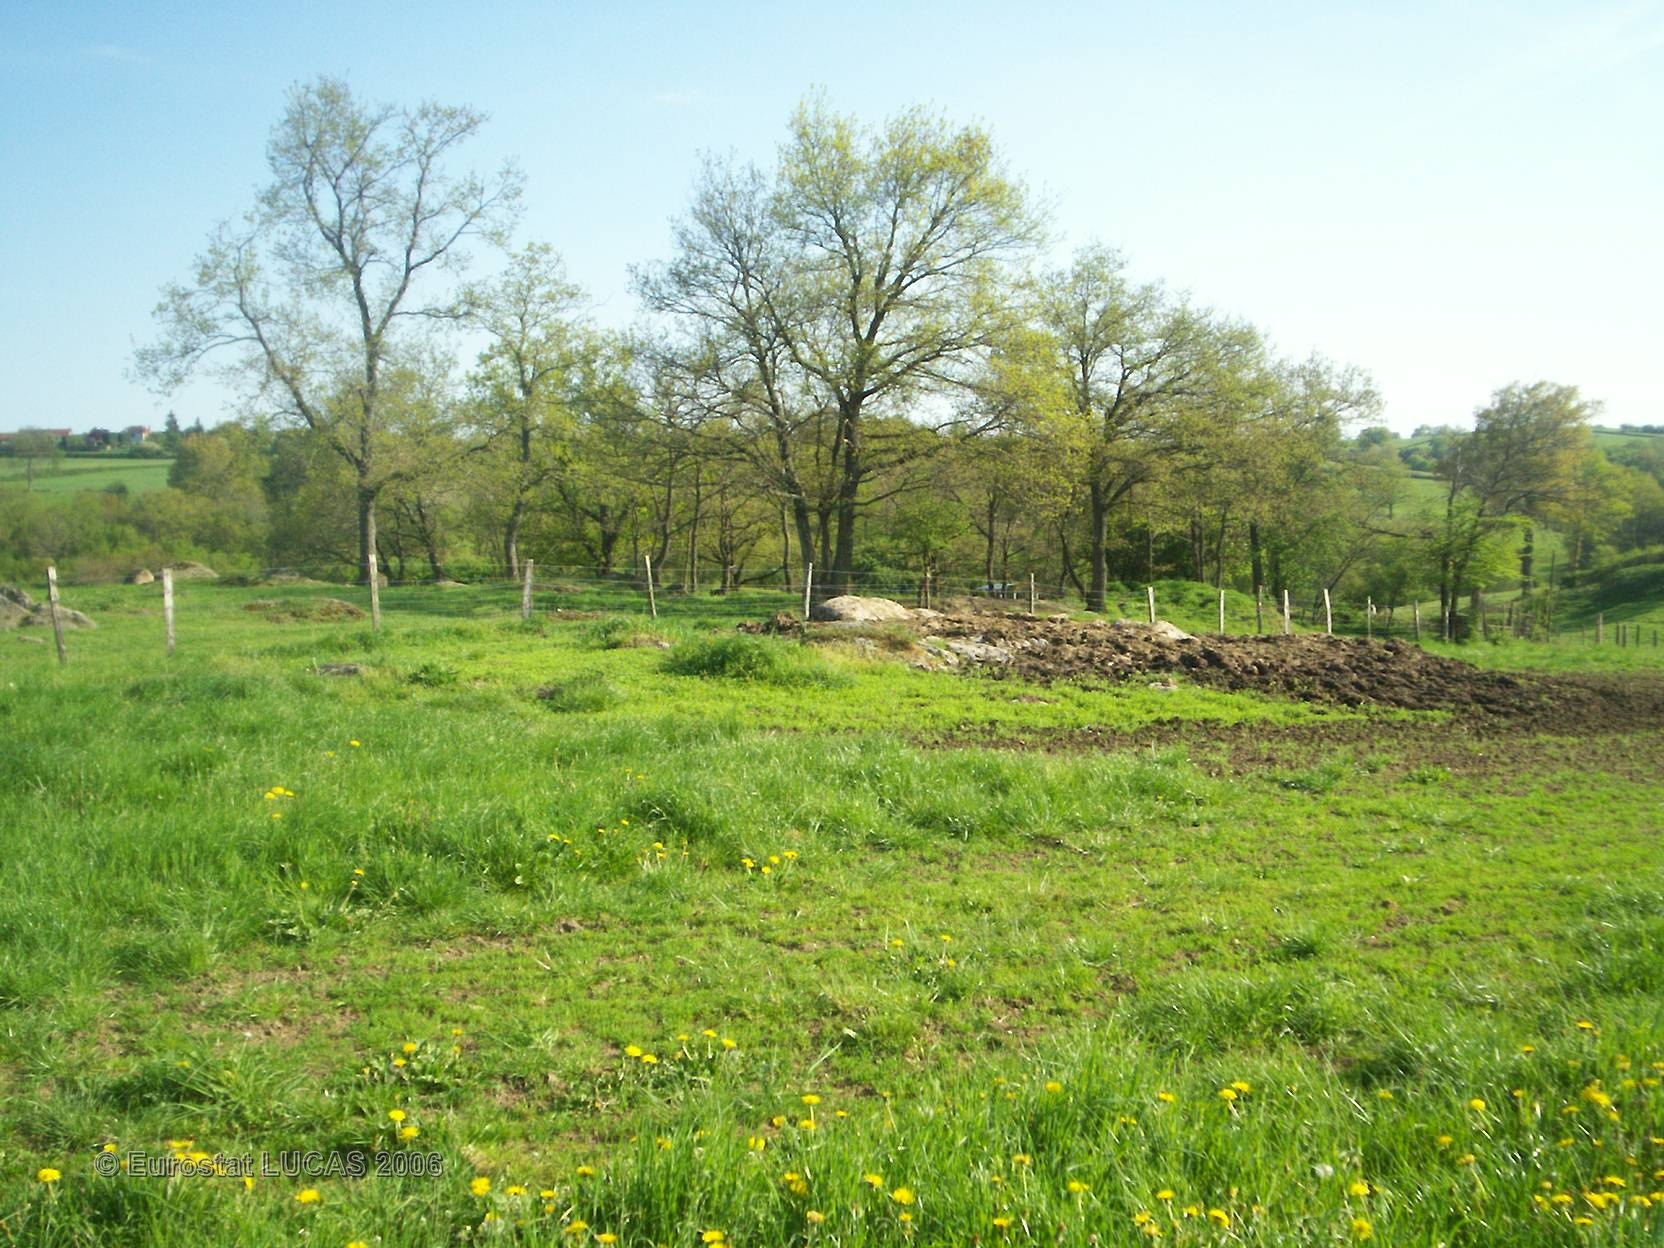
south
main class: Grassland
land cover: Grassland without tree/shrub cover
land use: Agriculture (excluding fallow land and kitchen gardens)
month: May
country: FR
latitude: 46.2504
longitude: 3.0326
